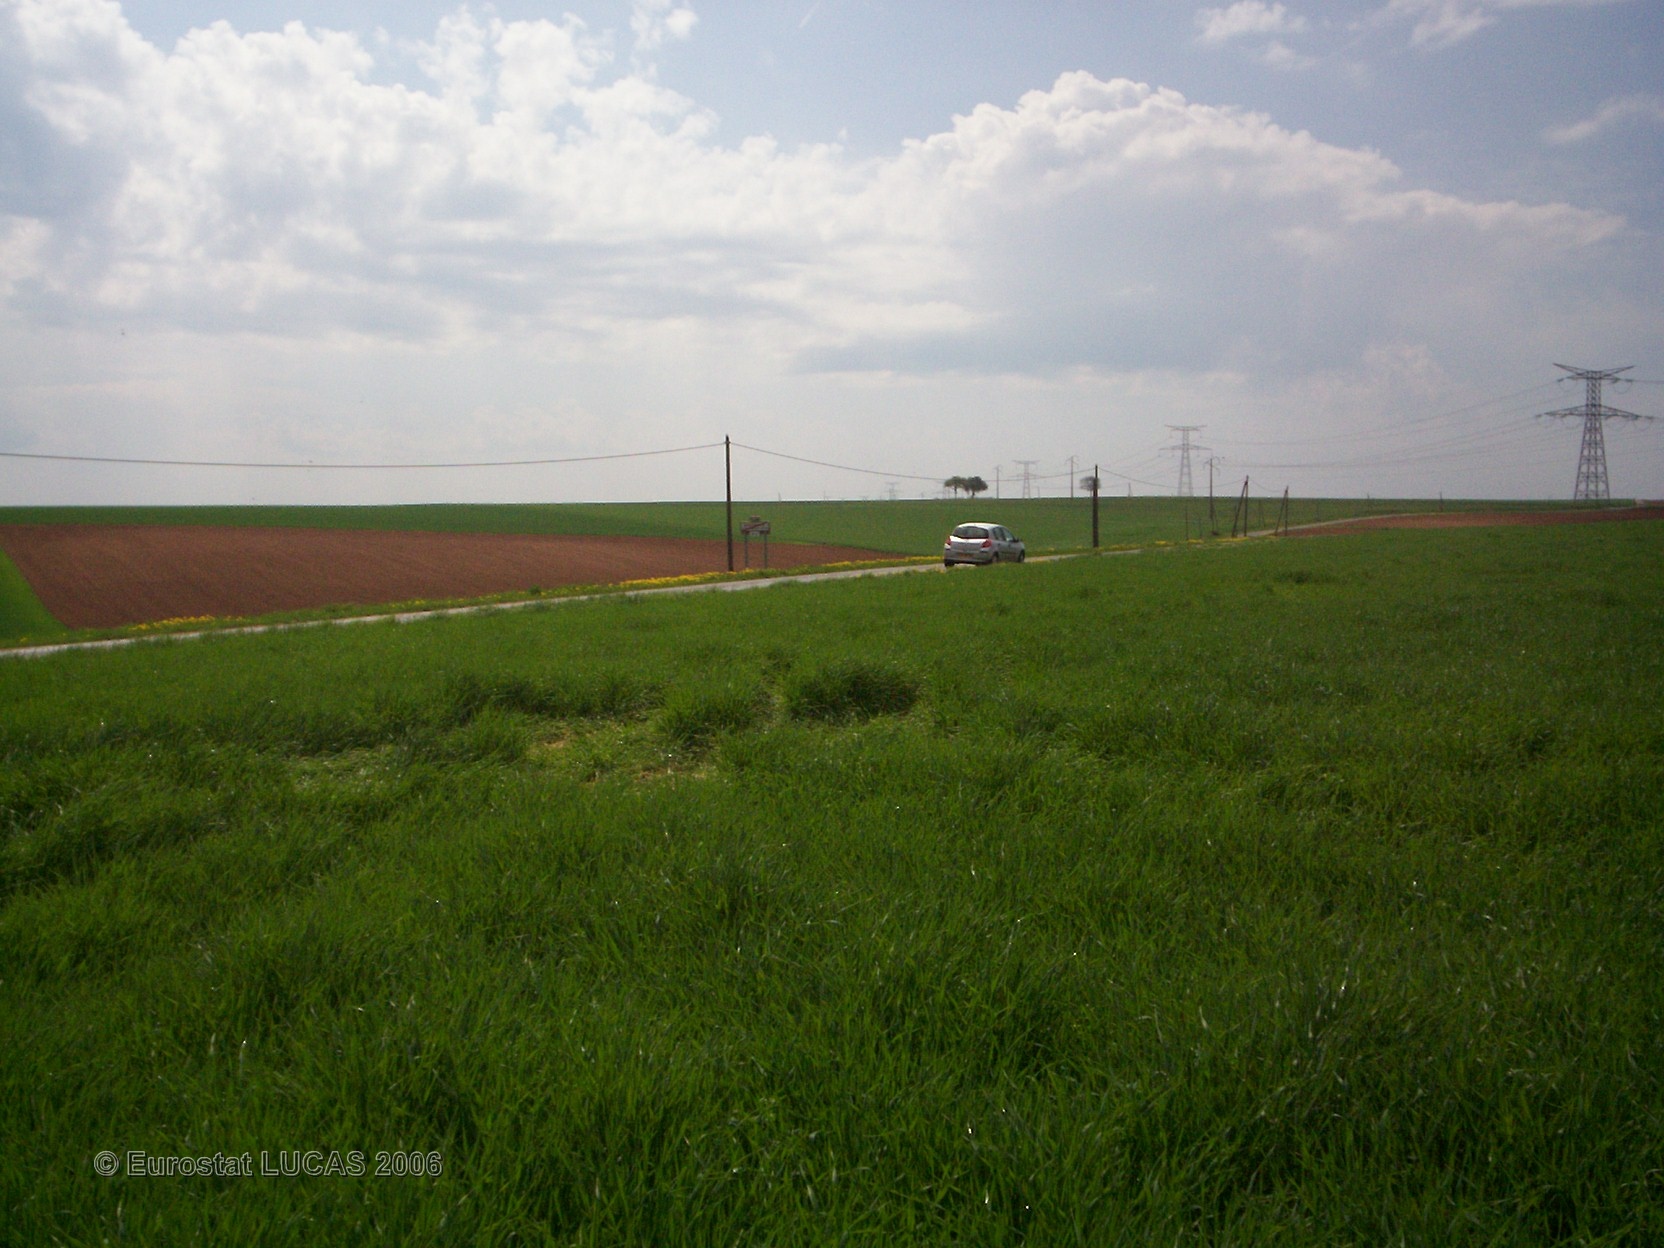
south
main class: Cropland
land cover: Barley
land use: Agriculture (excluding fallow land and kitchen gardens)
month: April
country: FR
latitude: 47.3339
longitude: 3.0207
